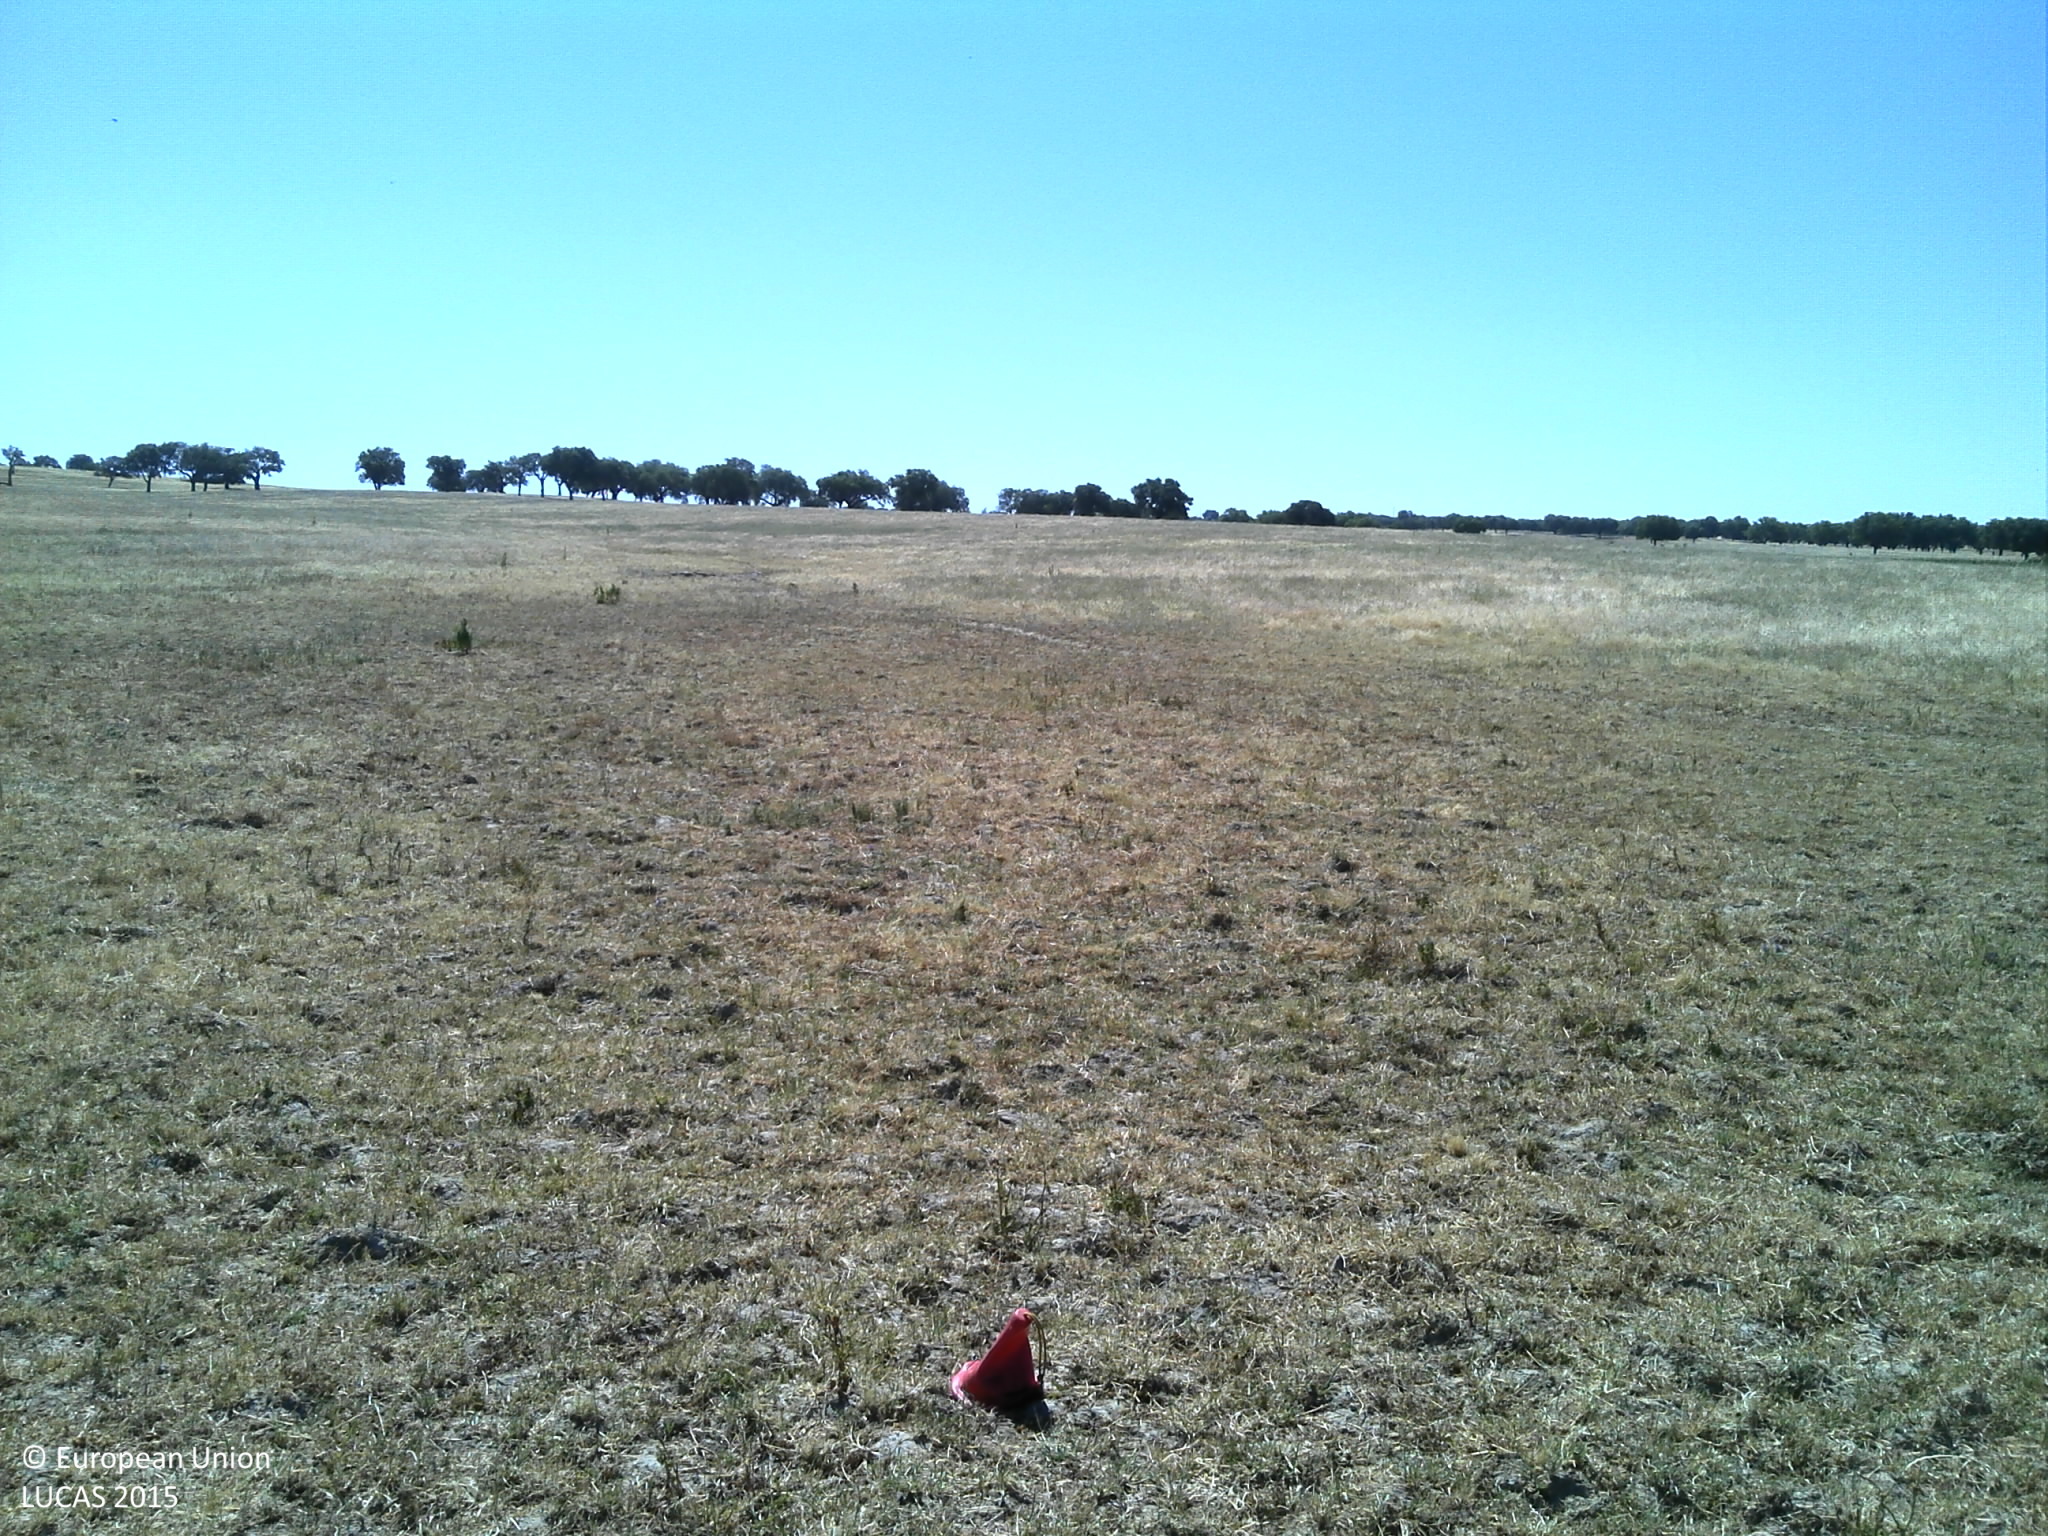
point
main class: Grassland
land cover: Spontaneously vegetated surfaces
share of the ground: > 75 %
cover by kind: herbaceous plants 75 %, unconsolidated bare surface 25 %
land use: Agriculture (excluding fallow land and kitchen gardens)
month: June
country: PT
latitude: 38.7486
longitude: -8.2187
